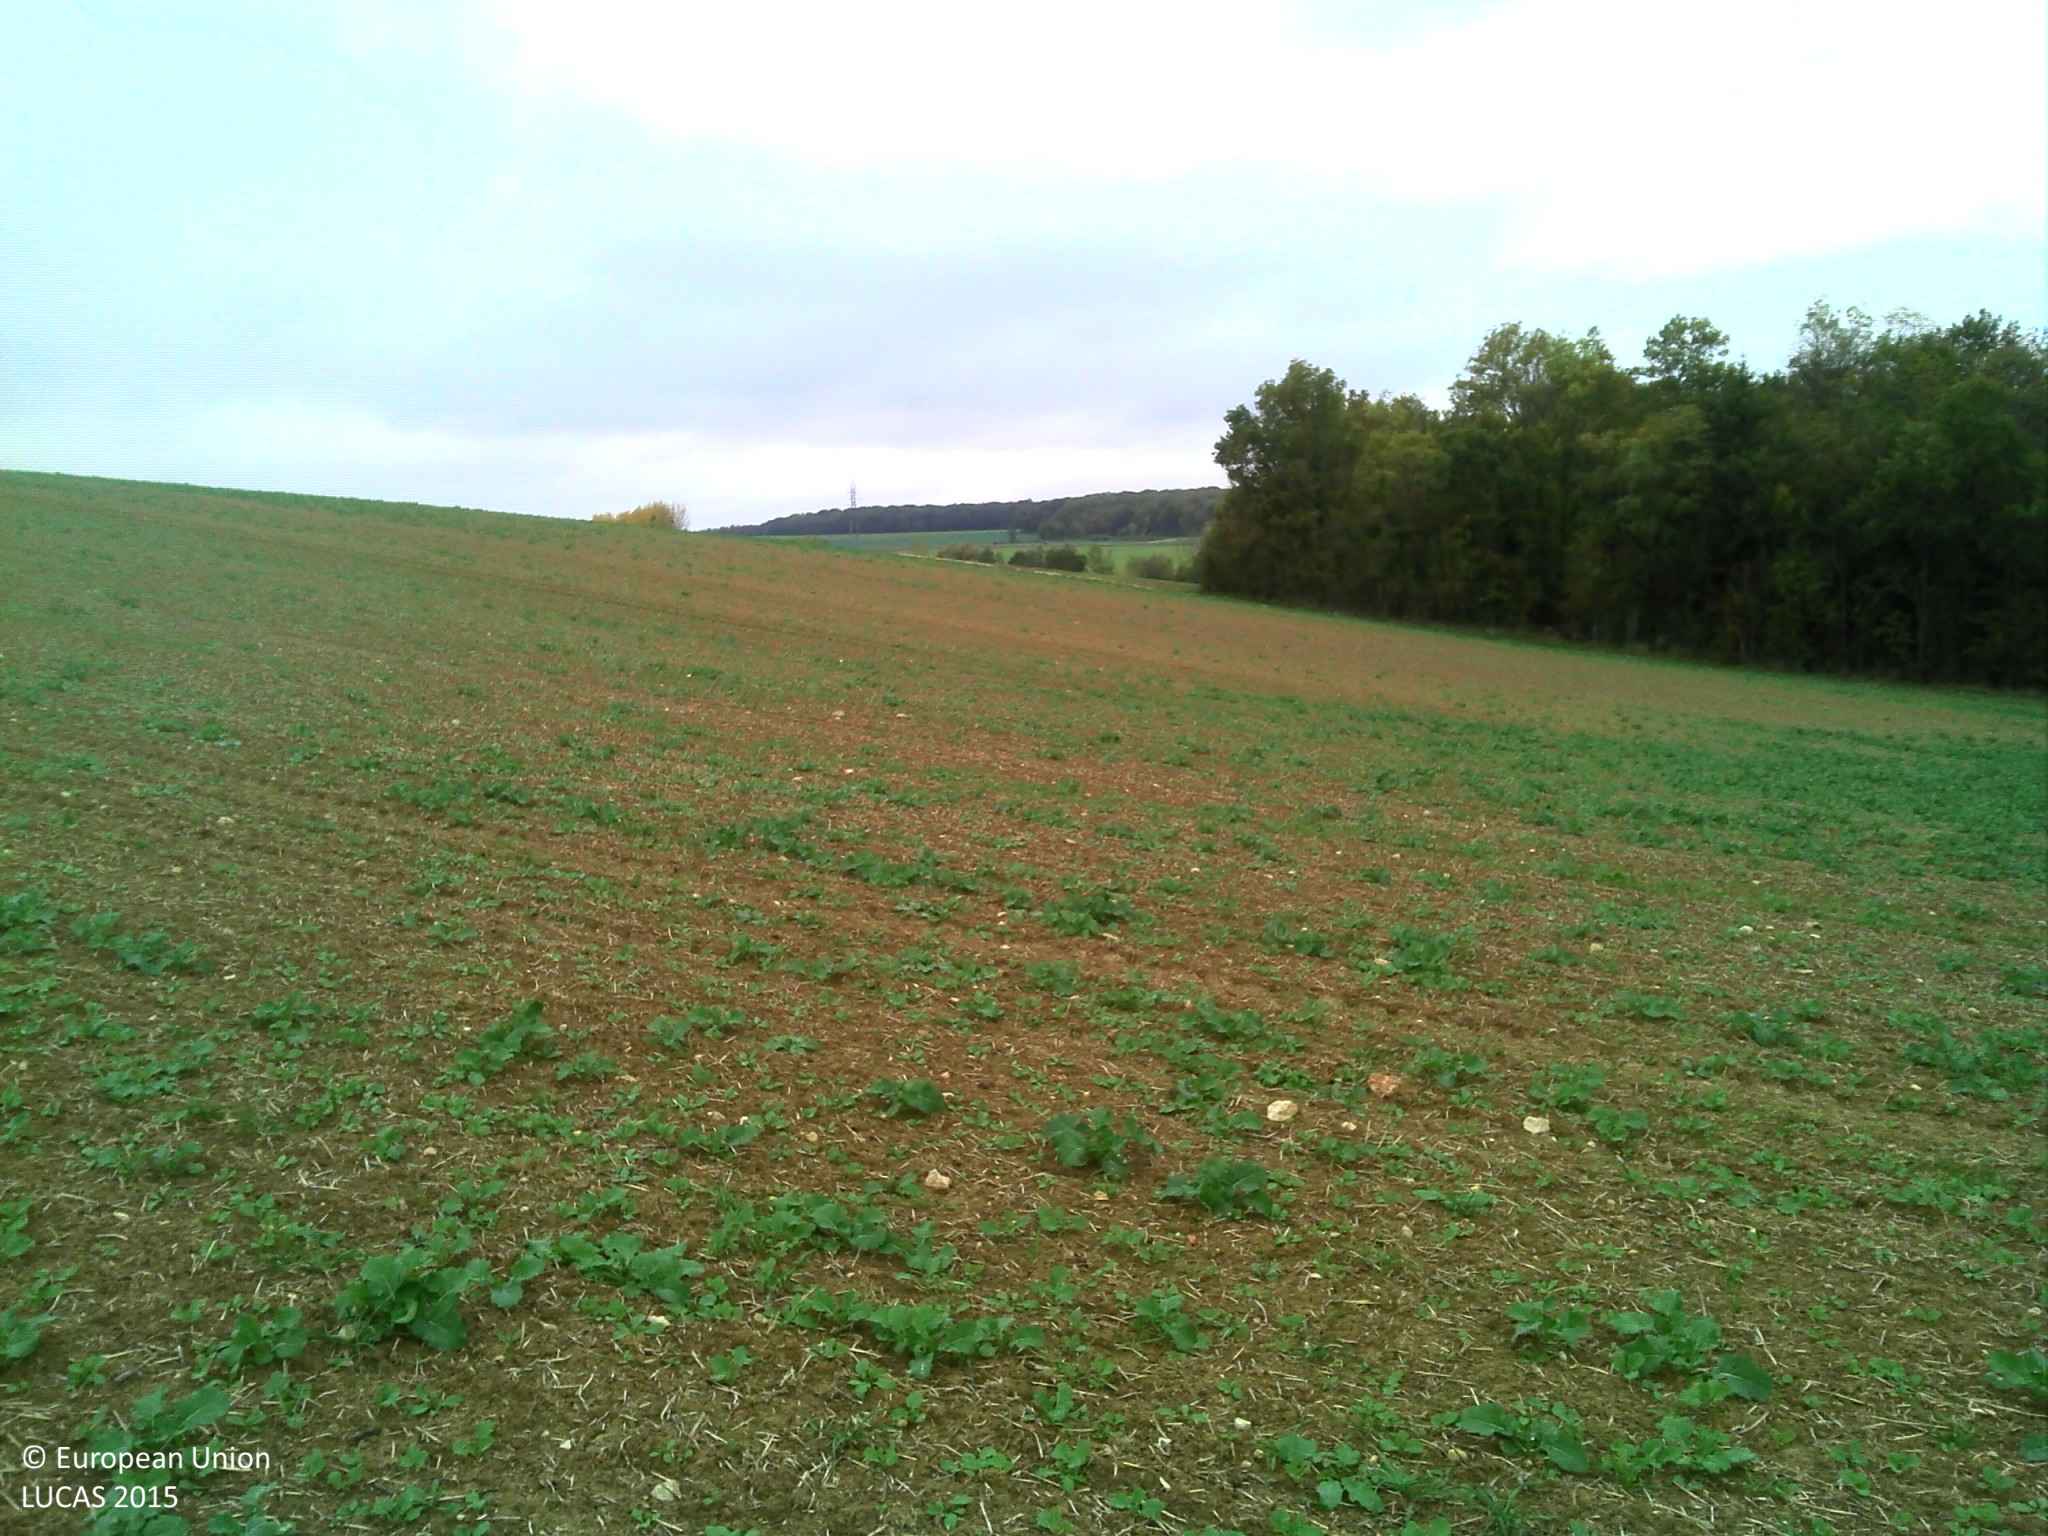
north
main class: Cropland
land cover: Rape and turnip rape
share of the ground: 10 - 25 %
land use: Agriculture (excluding fallow land and kitchen gardens)
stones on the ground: < 10 %
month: October
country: FR
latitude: 47.3898
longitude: 5.4305
